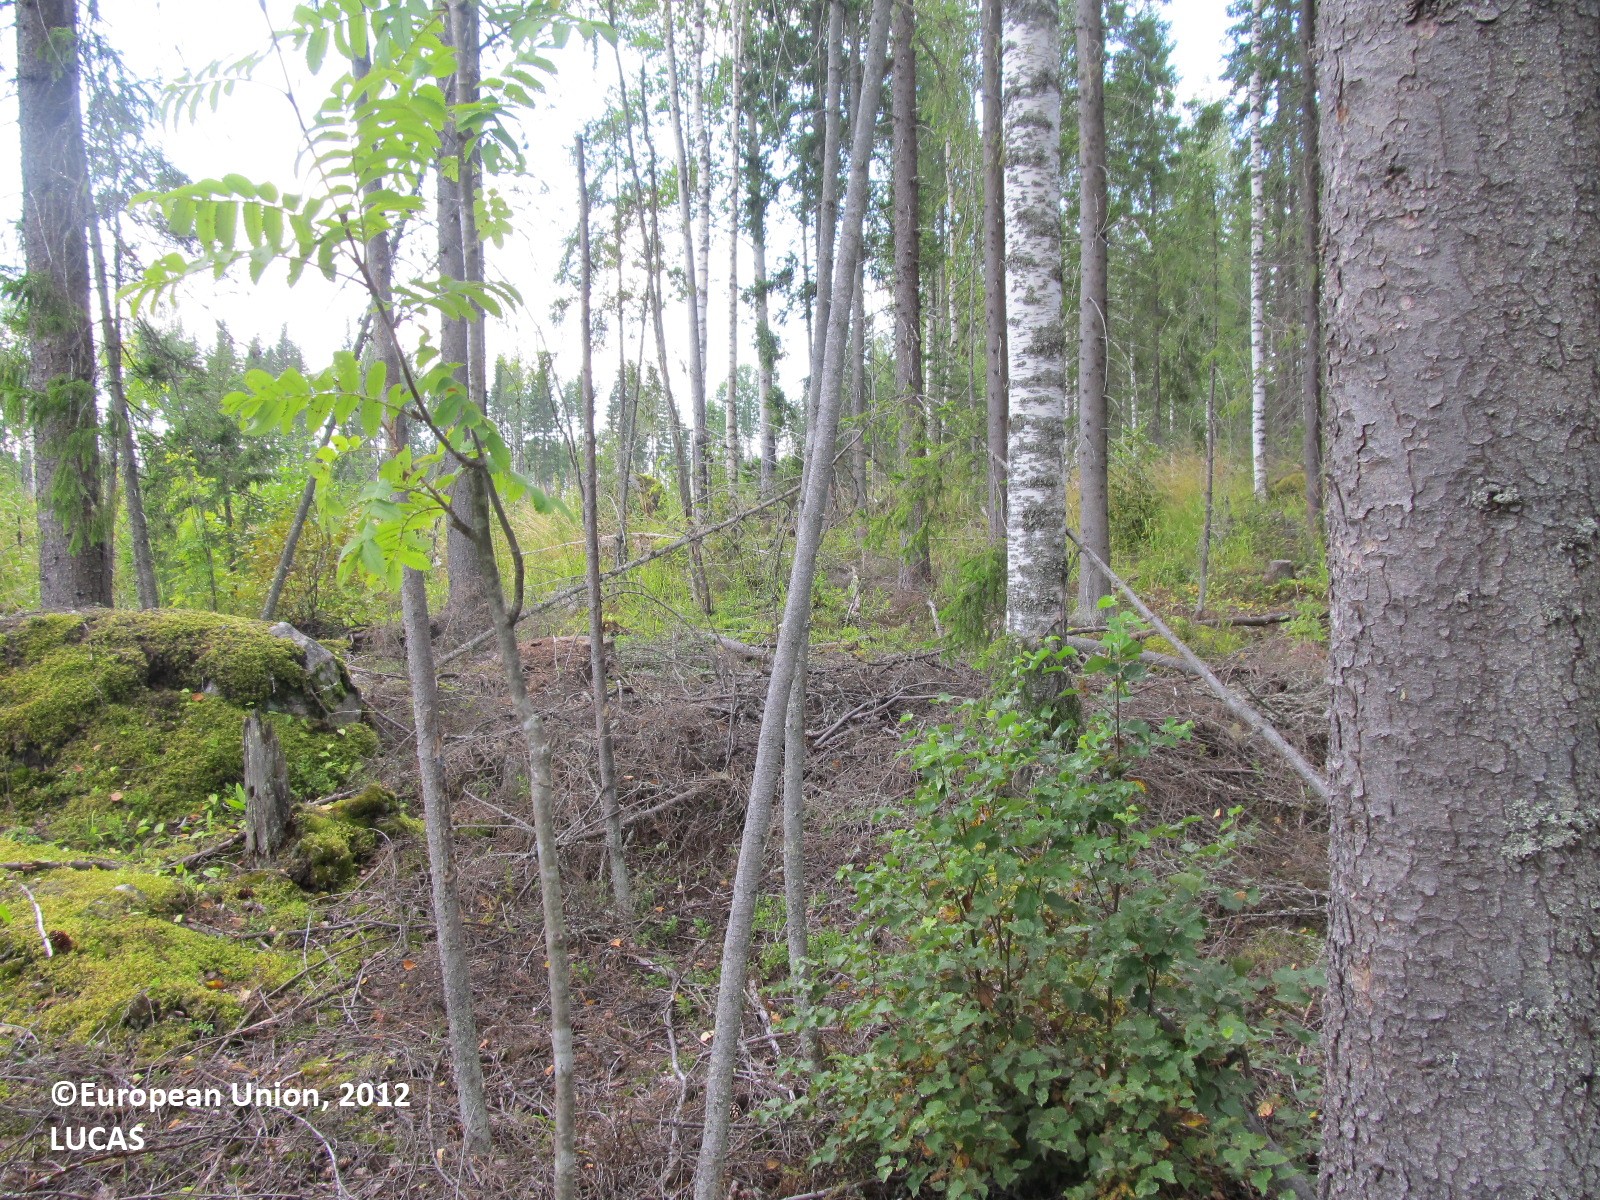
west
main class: Woodland
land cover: Spruce dominated mixed woodland
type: boreal forest
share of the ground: 25 - 50 %
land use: Forestry
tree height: > 5 m
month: August
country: FI
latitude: 62.4533
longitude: 27.7558
